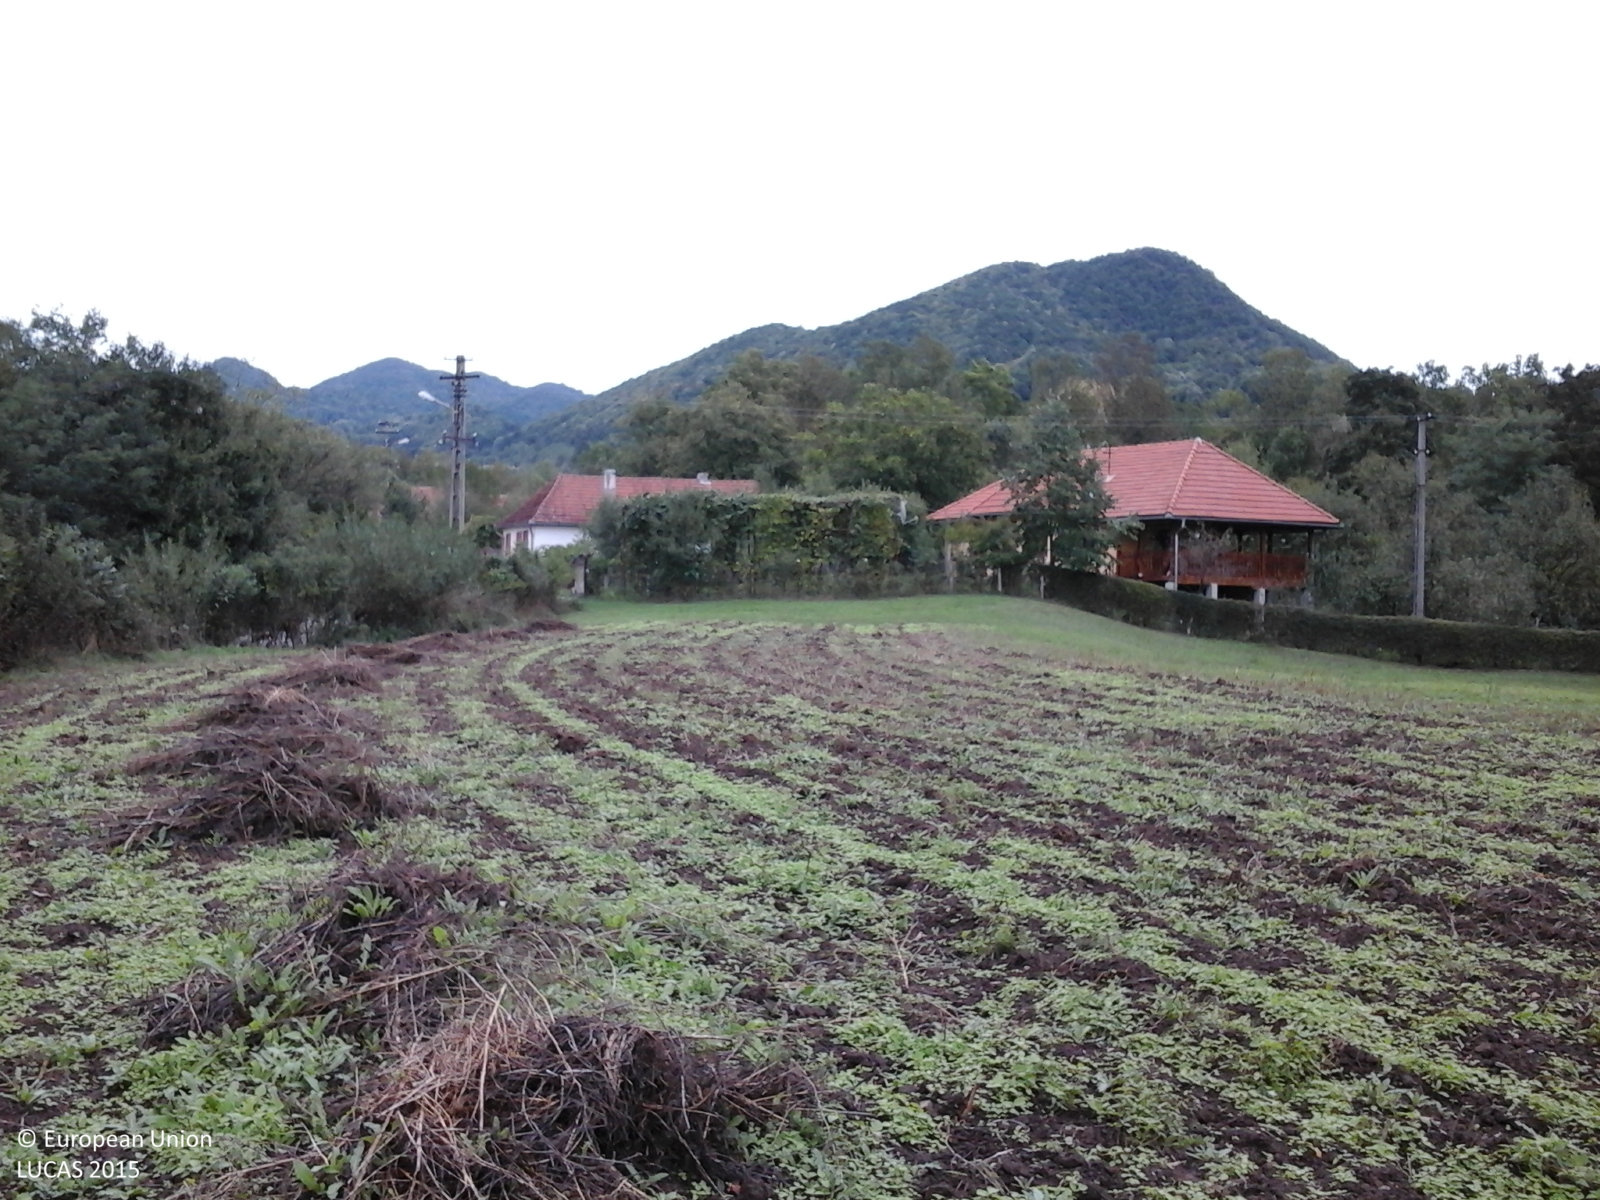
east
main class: Cropland
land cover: Maize
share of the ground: < 10 %
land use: Agriculture (excluding fallow land and kitchen gardens)
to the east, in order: Maize; Grassland without tree/shrub cover; Fences; Artificial constructions in urban areas; Broadleaved woodland; Fences; Grassland without tree/shrub cover; Fences; Broadleaved woodland; Other fruit trees and berries; Grassland with sparse tree/shrub cover
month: September
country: RO
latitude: 45.9555
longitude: 22.9966
